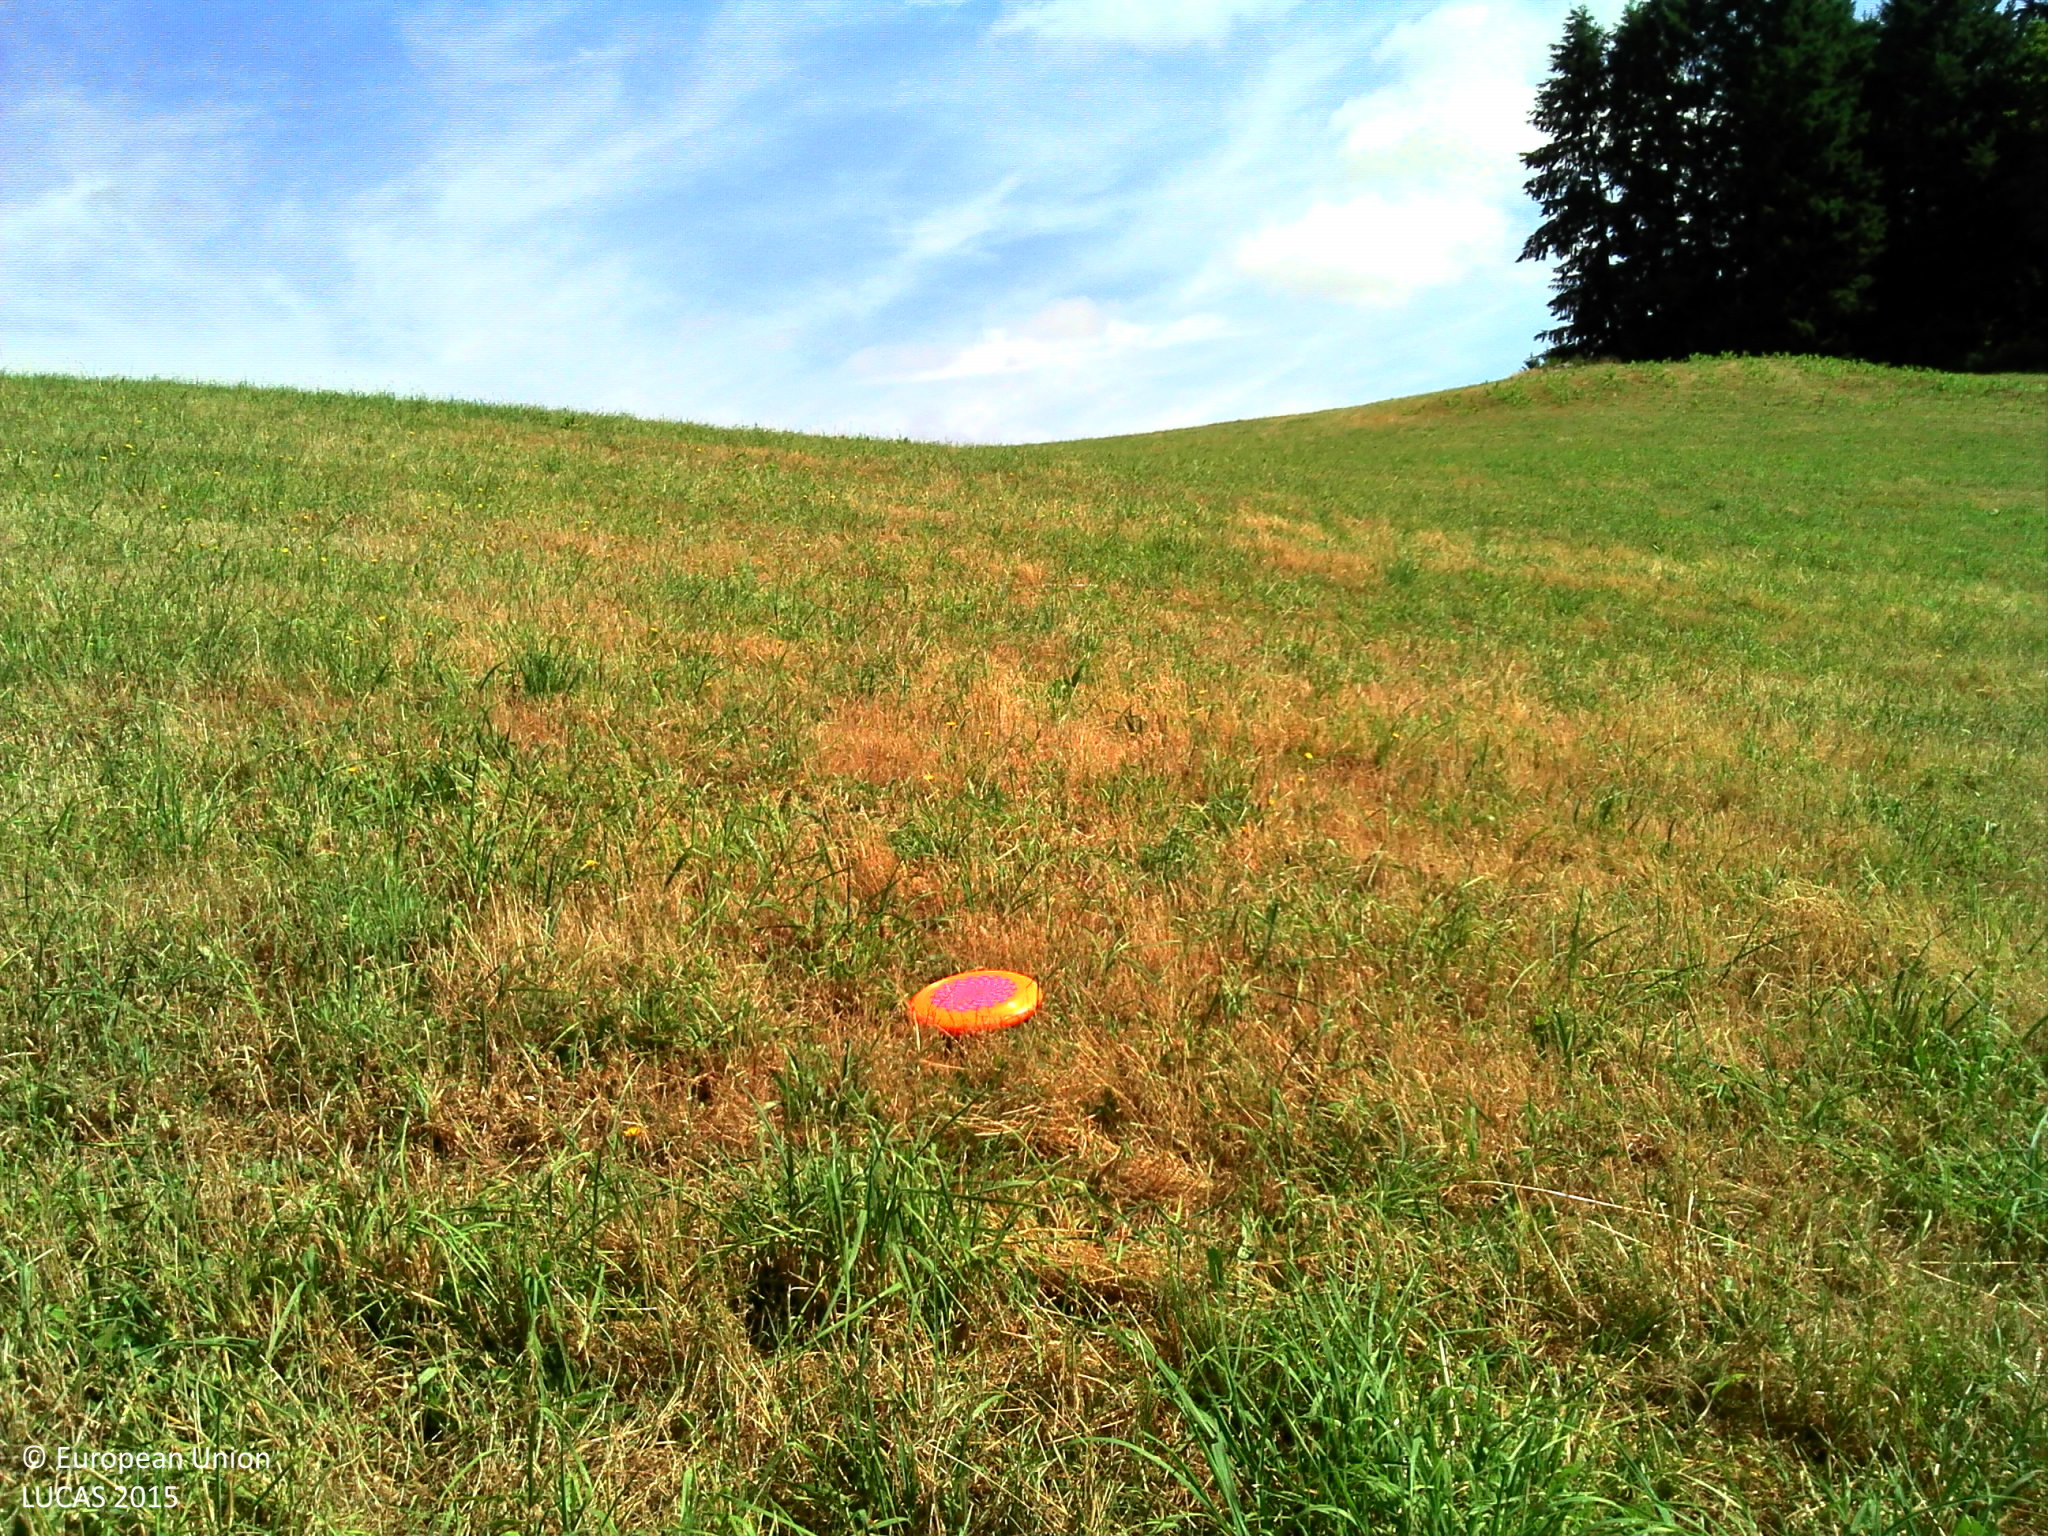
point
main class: Grassland
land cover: Grassland without tree/shrub cover
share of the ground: > 75 %
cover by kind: herbaceous plants 95 %
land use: Agriculture (excluding fallow land and kitchen gardens)
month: July
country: FR
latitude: 45.7767
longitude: 1.7243
